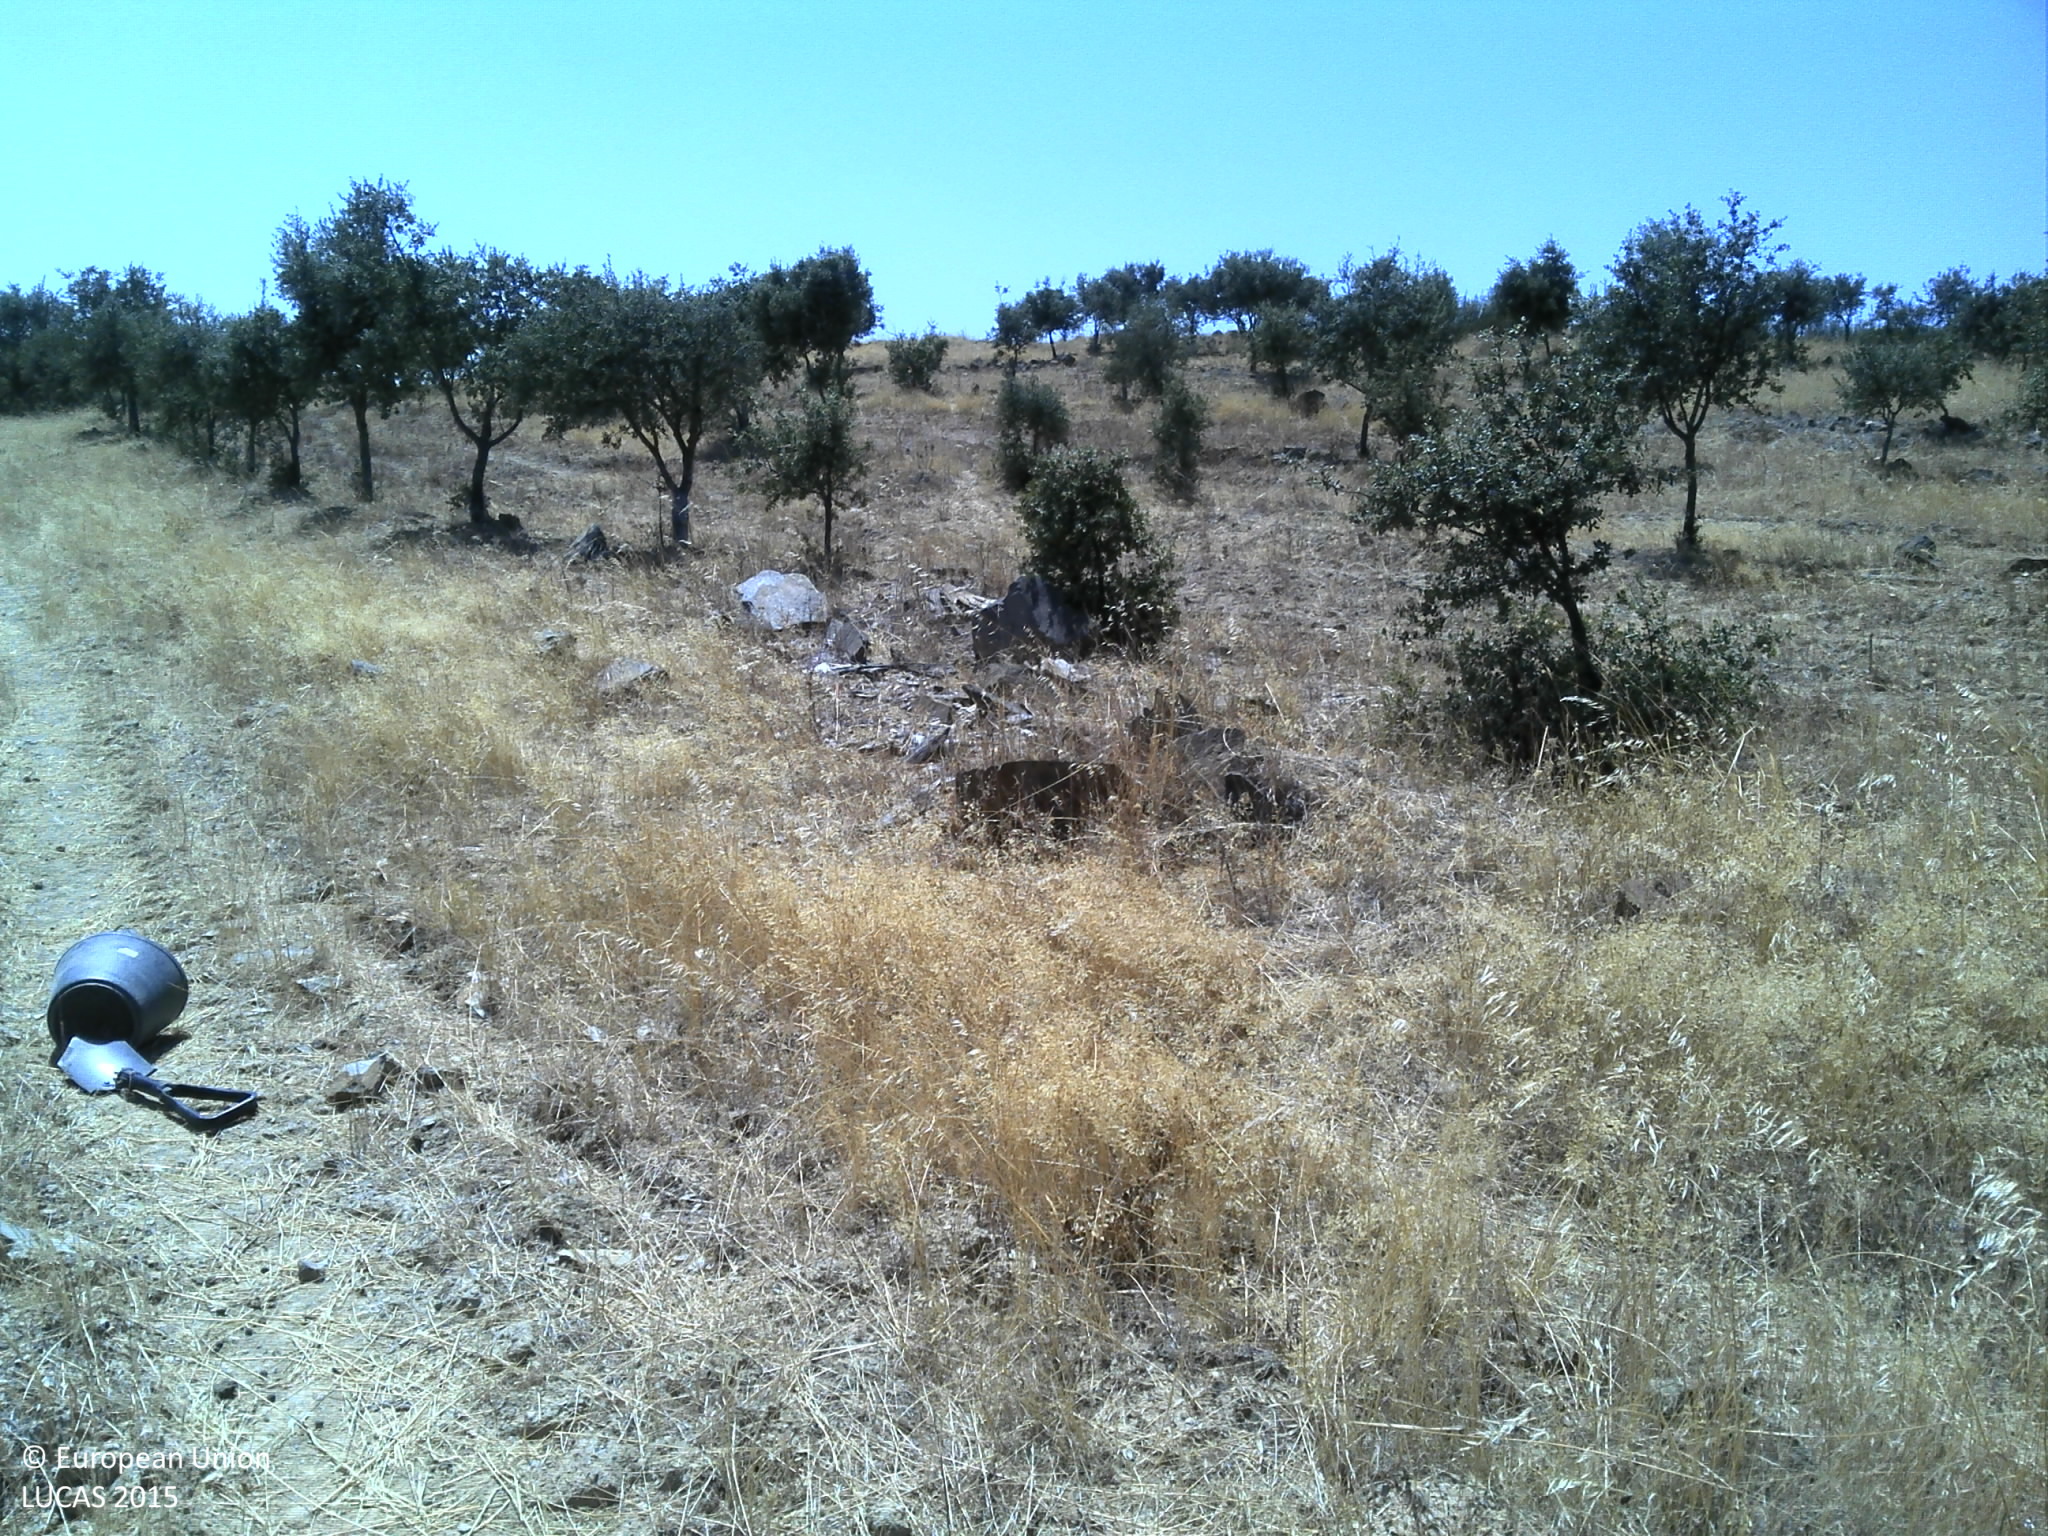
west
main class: Woodland
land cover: Broadleaved woodland
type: broadleaved evergreen forest
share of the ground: 10 - 25 %
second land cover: Grassland without tree/shrub cover
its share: 50 - 75 %
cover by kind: herbaceous plants 60 %, broadleaved forest trees 20 %, unconsolidated bare surface 15 %, consolidated bare surface 5 %
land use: Forestry
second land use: Agriculture (excluding fallow land and kitchen gardens)
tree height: < 5 m
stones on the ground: < 10 %
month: July
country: PT
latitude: 37.6329
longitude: -7.9602
